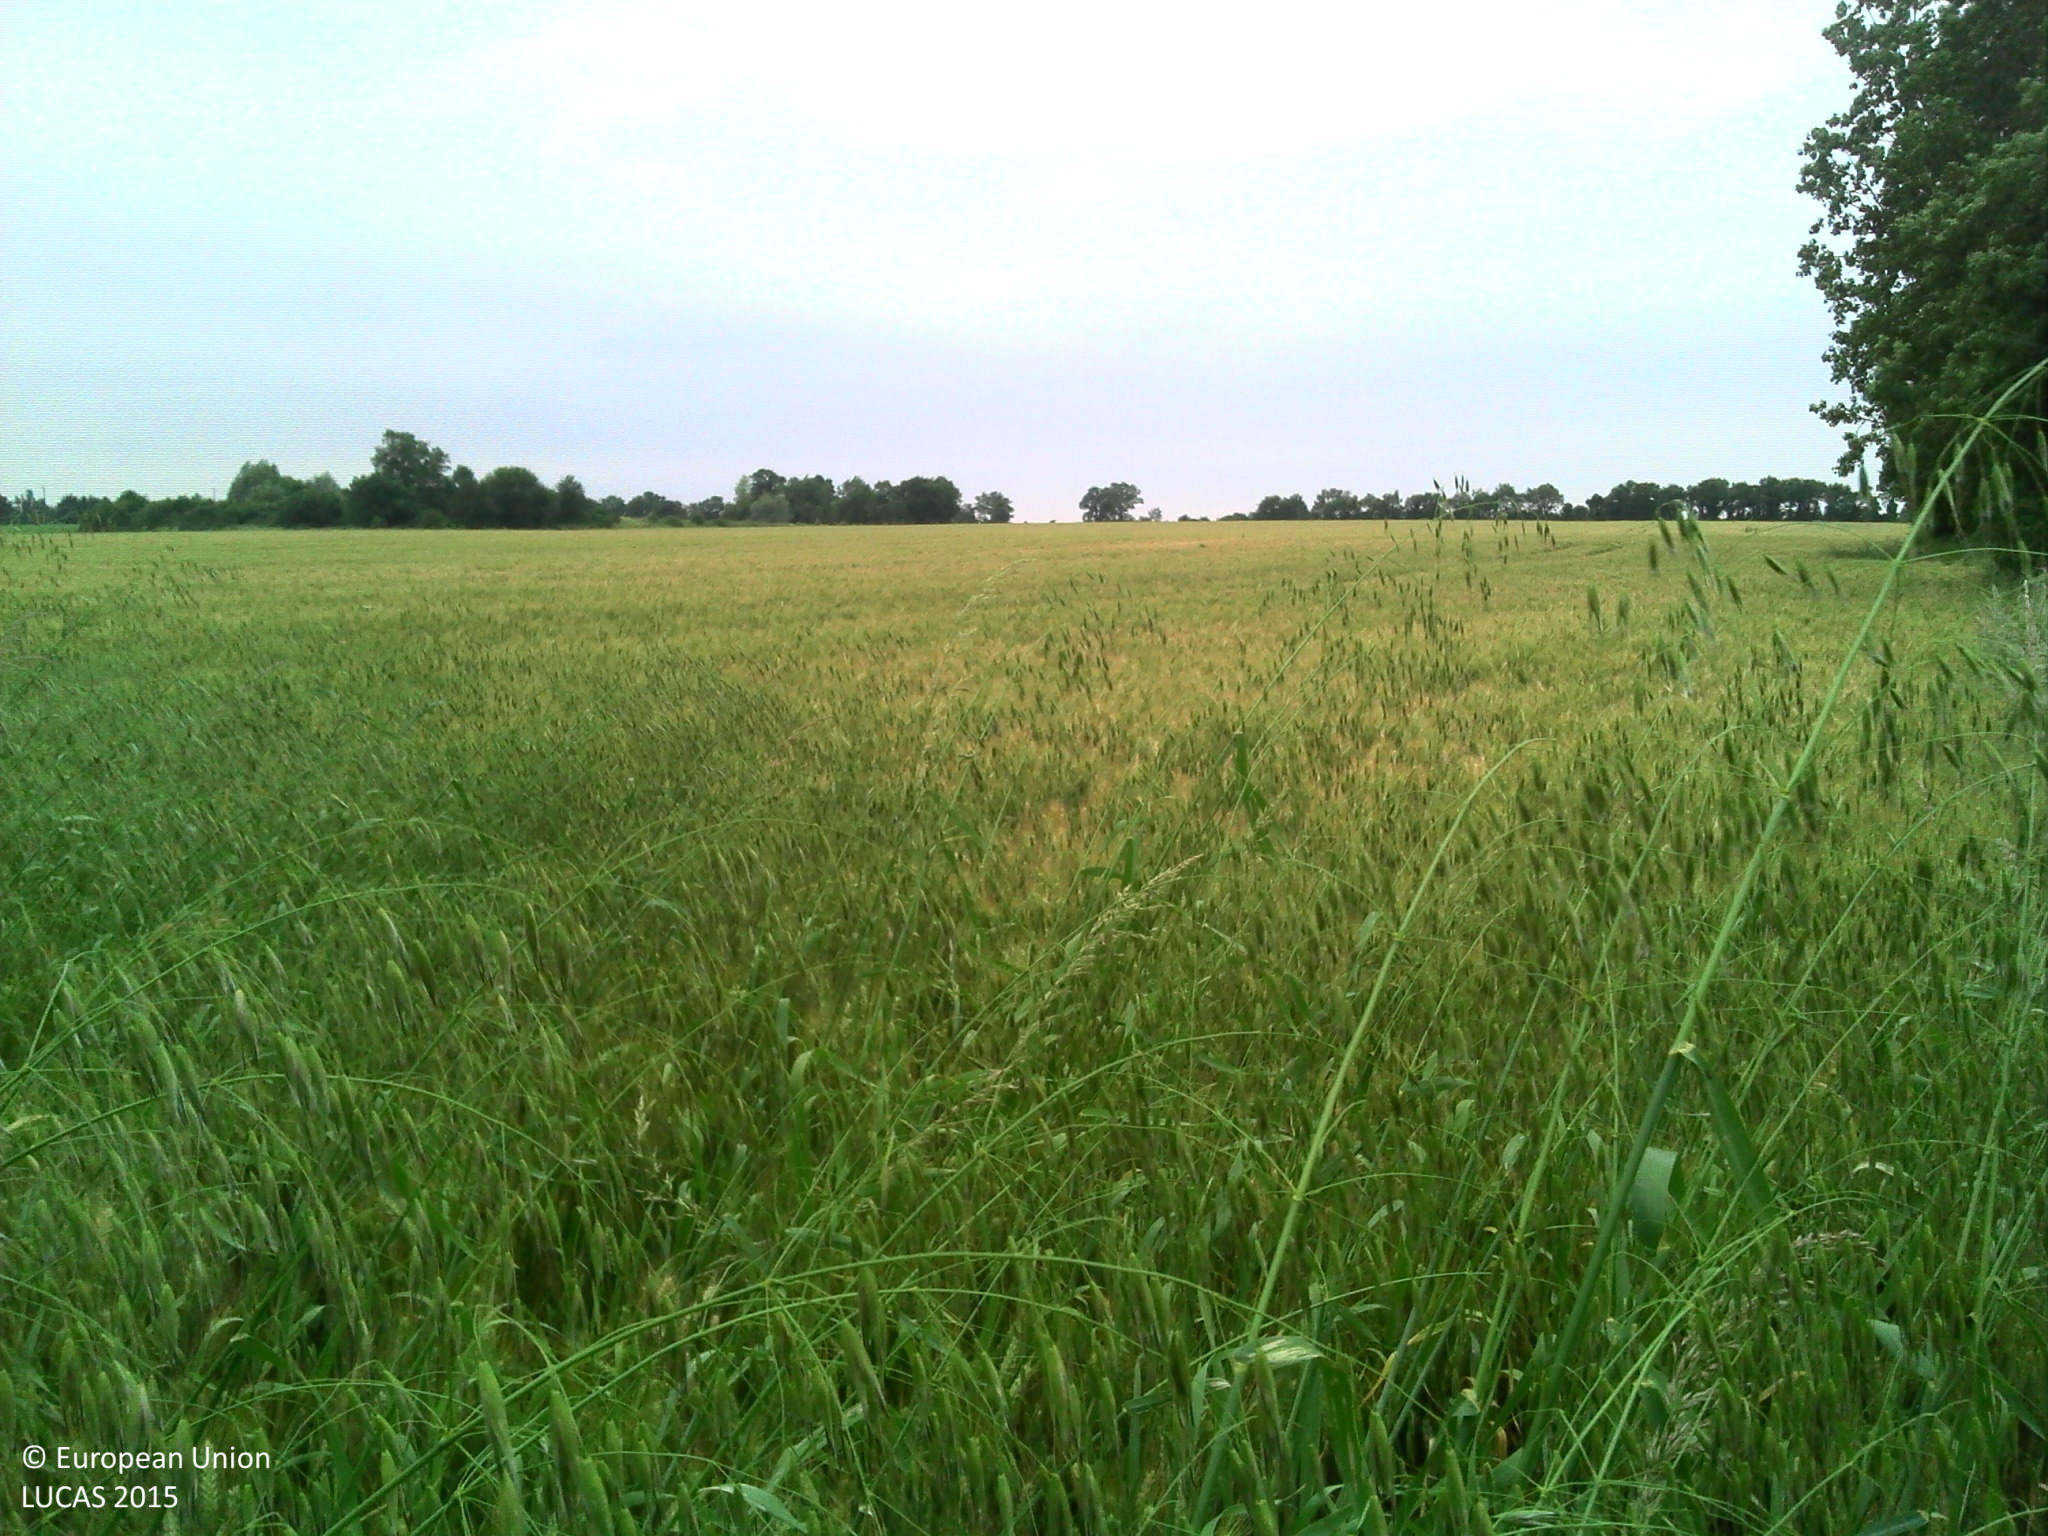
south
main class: Cropland
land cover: Common wheat
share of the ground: > 75 %
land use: Agriculture (excluding fallow land and kitchen gardens)
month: June
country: FR
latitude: 46.9665
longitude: -1.4875
